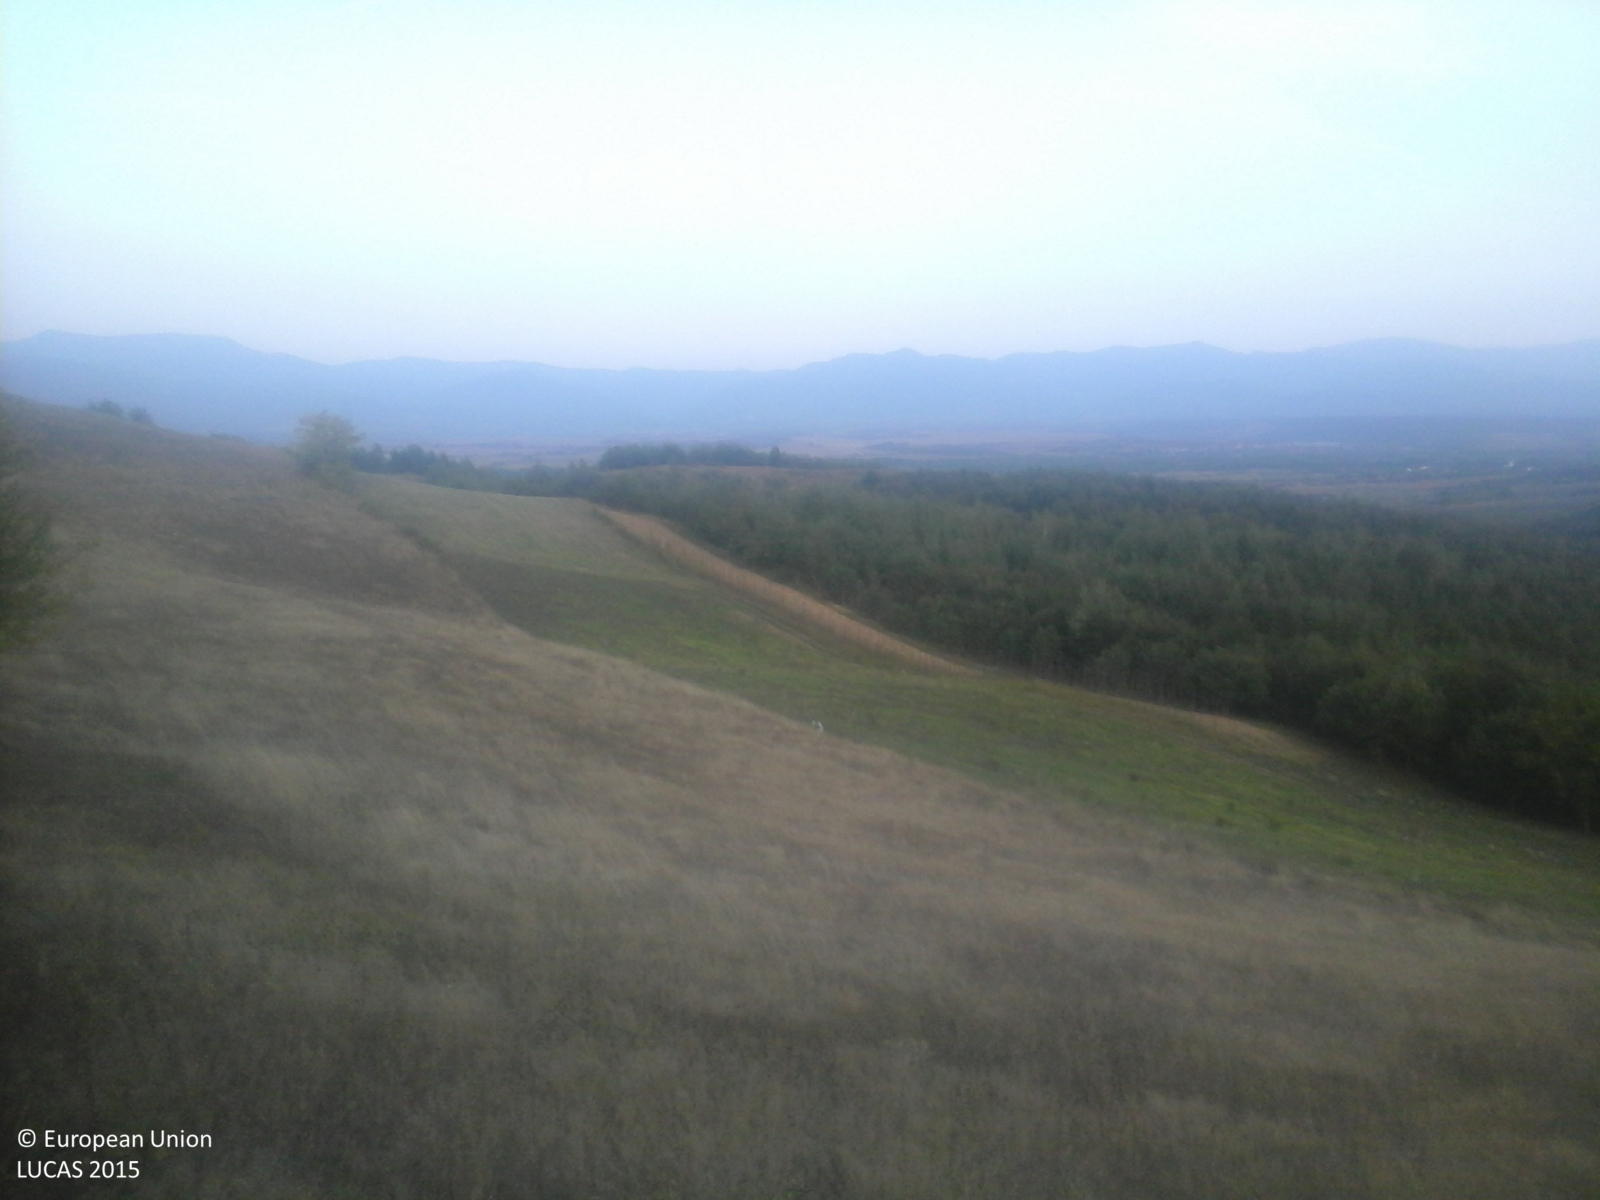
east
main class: Grassland
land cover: Spontaneously vegetated surfaces
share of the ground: > 75 %
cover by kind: herbaceous plants 100 %
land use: Fallow land
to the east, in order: Spontaneously vegetated surfaces; Other leguminous and mixtures for fodder; Dry pulses; Potatoes; Broadleaved woodland
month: September
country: RO
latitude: 46.5935
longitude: 22.3850
